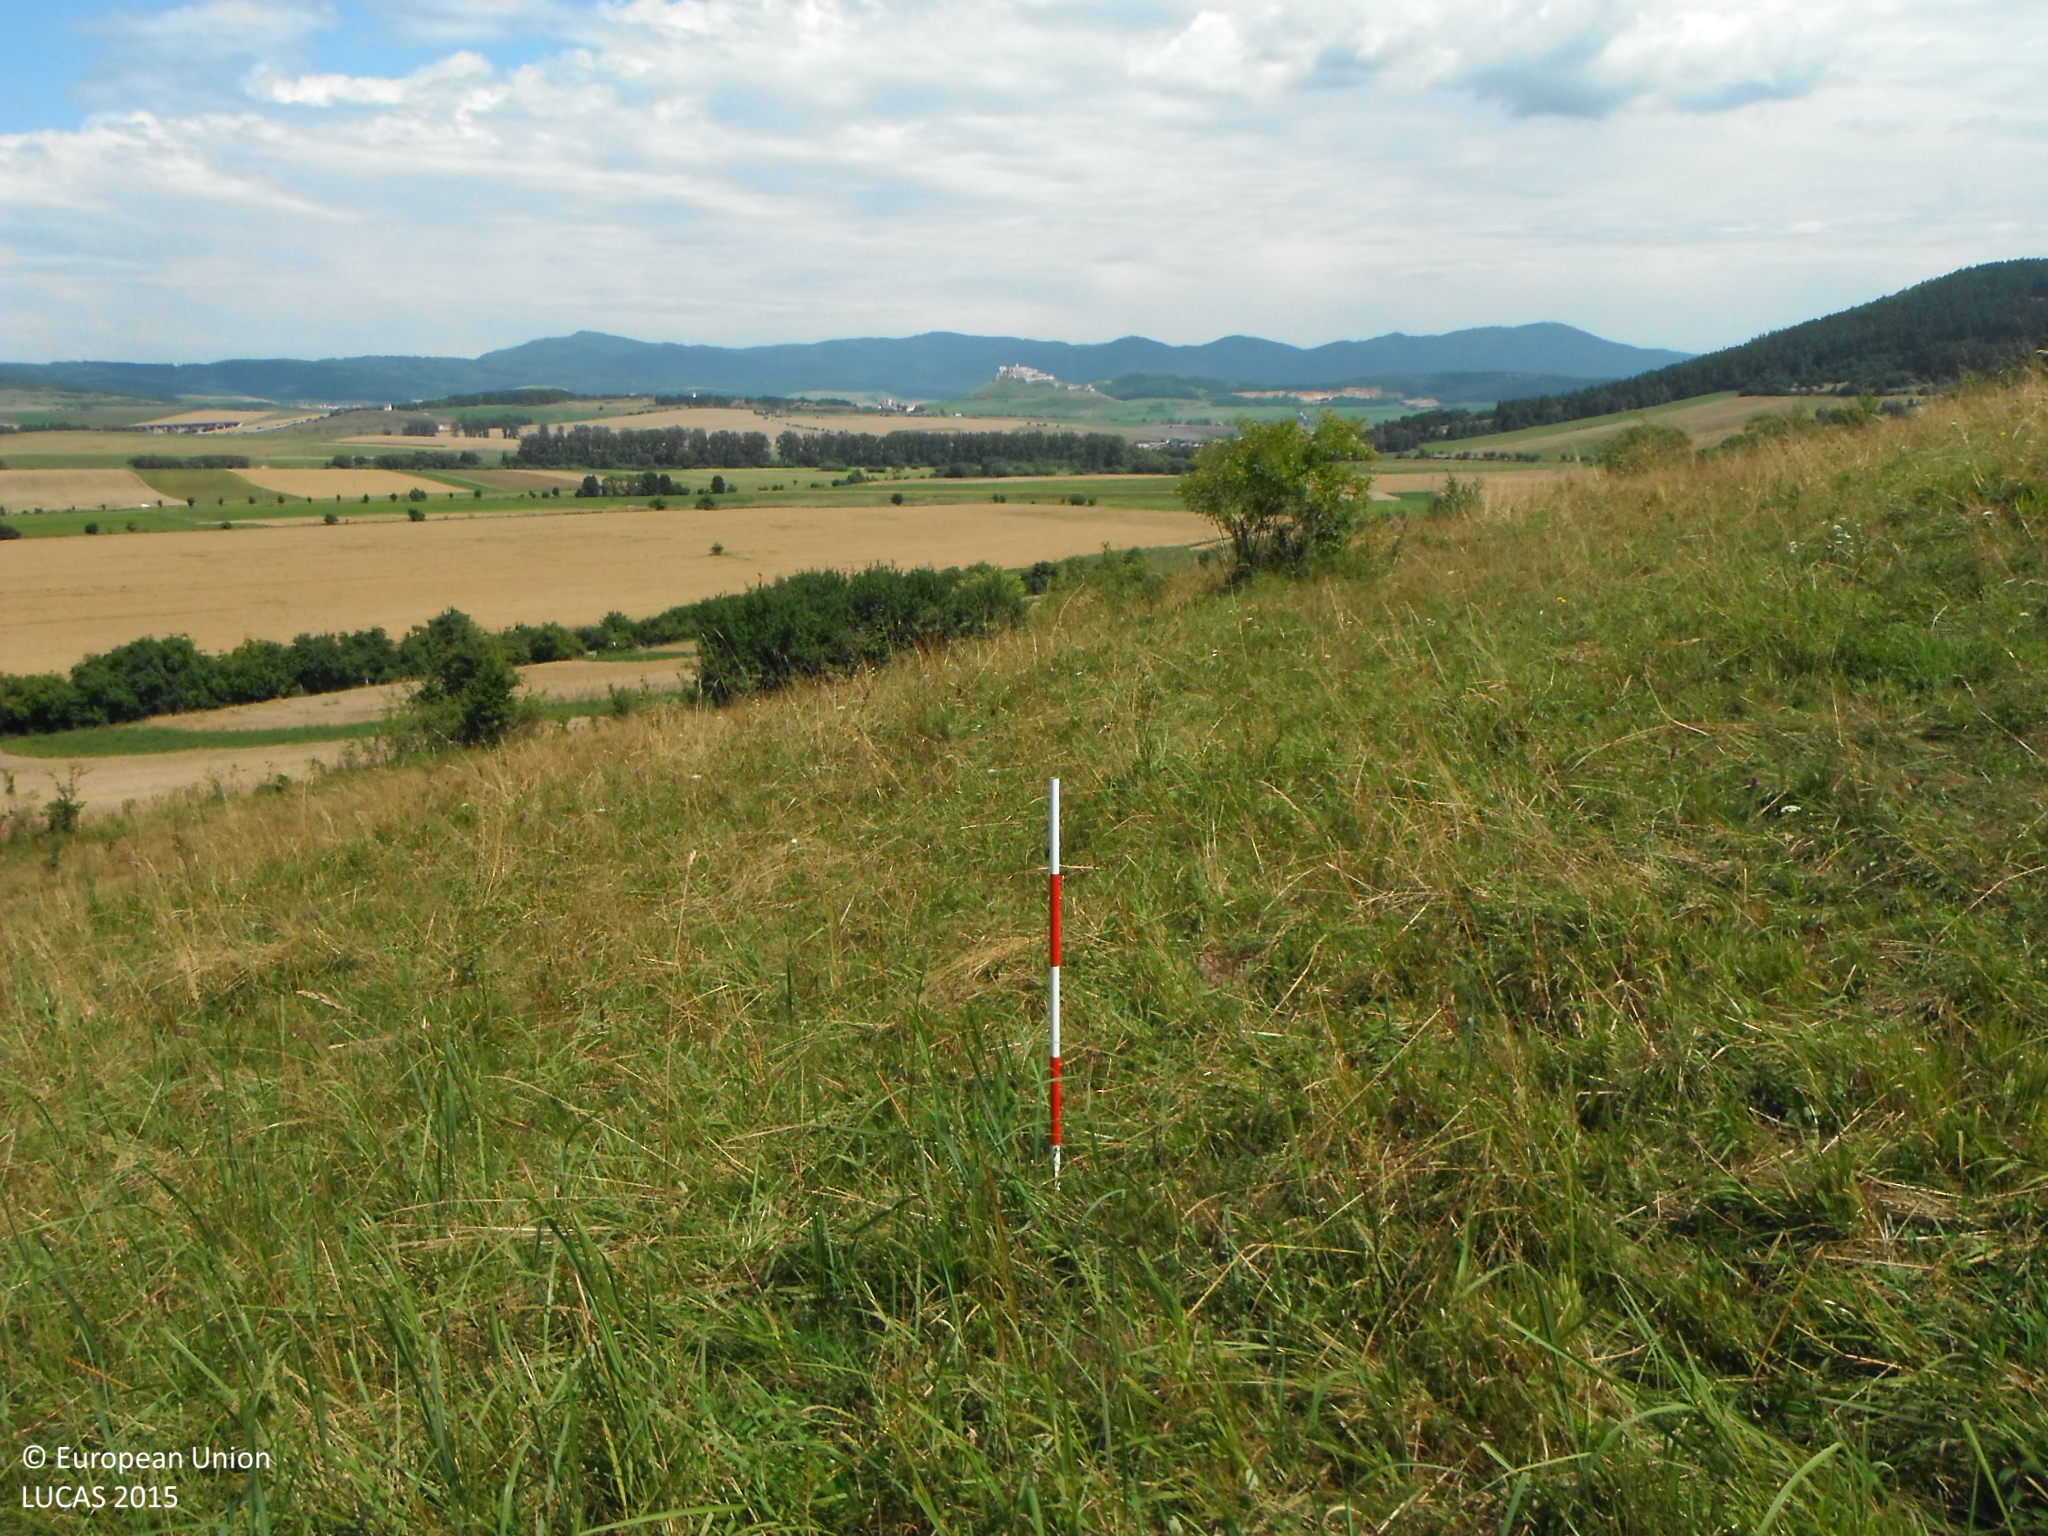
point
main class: Grassland
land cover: Grassland without tree/shrub cover
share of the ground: > 75 %
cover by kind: herbaceous plants 100 %
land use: Agriculture (excluding fallow land and kitchen gardens)
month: July
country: SK
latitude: 48.9912
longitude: 20.6843
